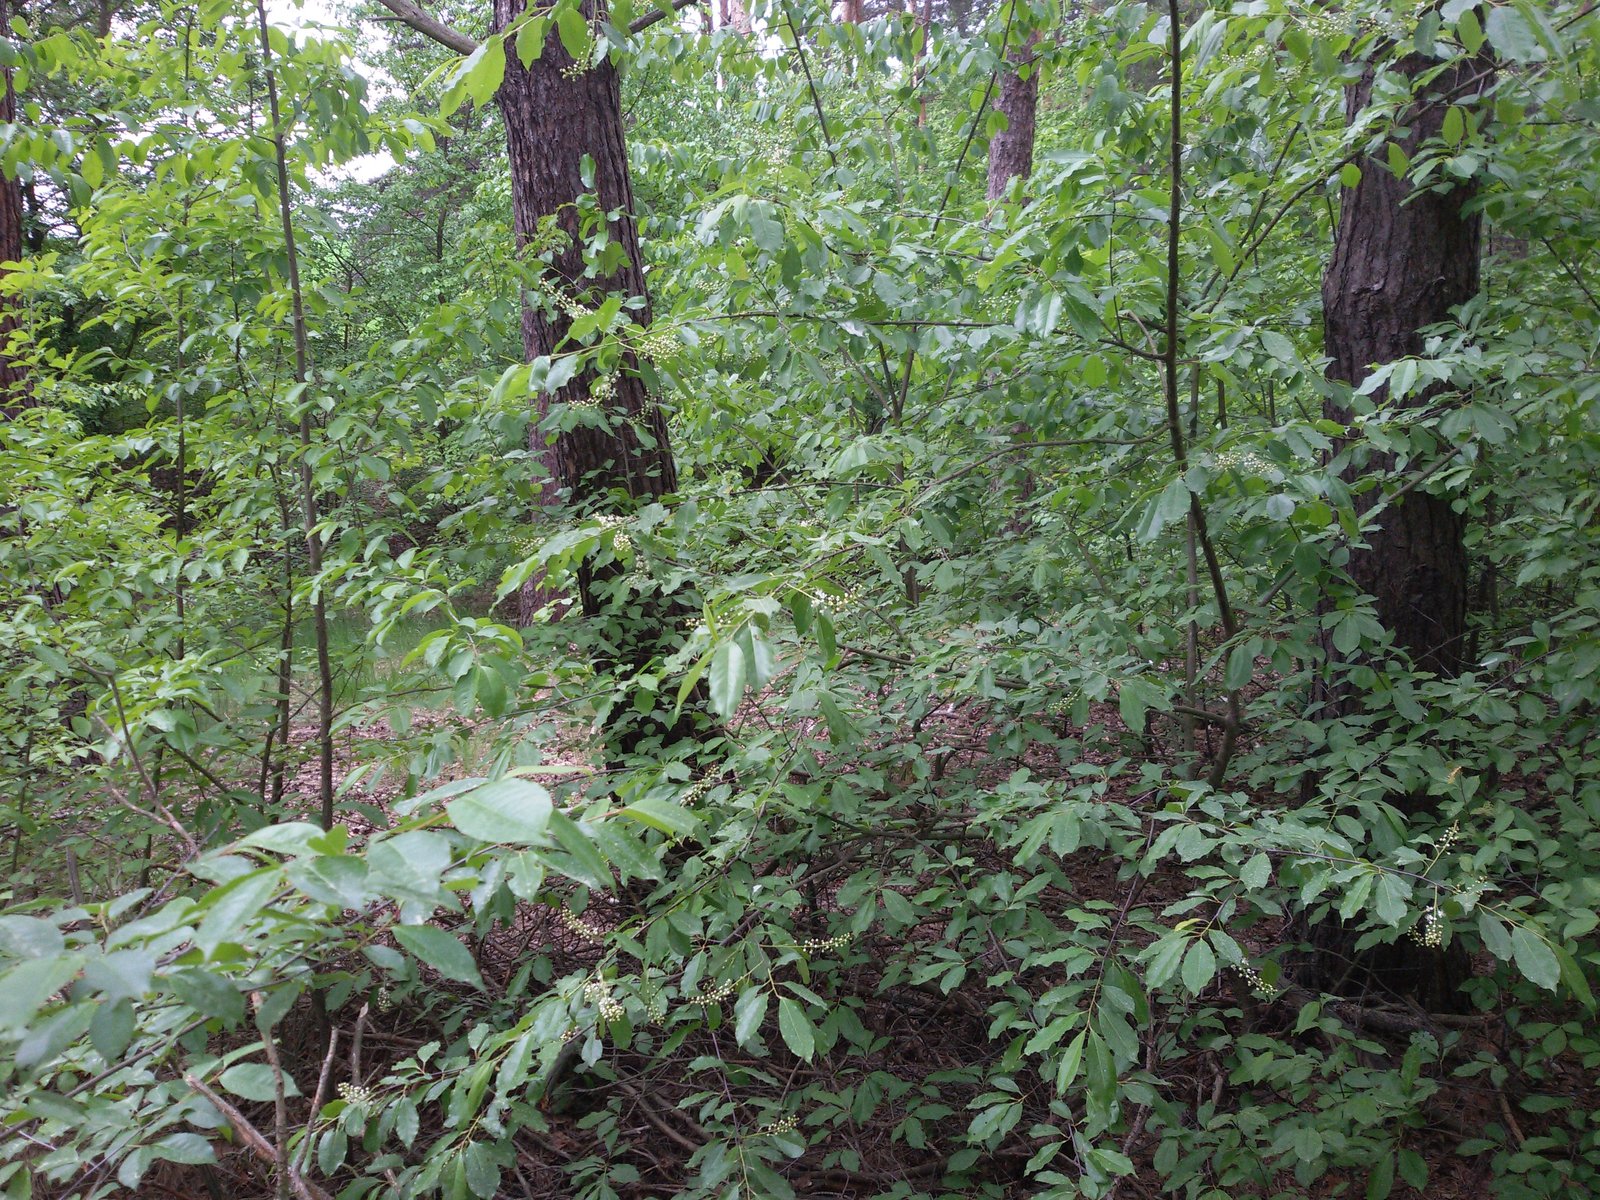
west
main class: Woodland
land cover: Pine dominated coniferous woodland
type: hemiboreal forest and nemoral coniferous forest and mixed broadleaved-coniferous forest
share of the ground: > 75 %
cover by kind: coniferous forest trees 80 %, shrubs 20 %
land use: Forestry
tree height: > 5 m
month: May
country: PL
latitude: 52.6134
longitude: 17.1438
